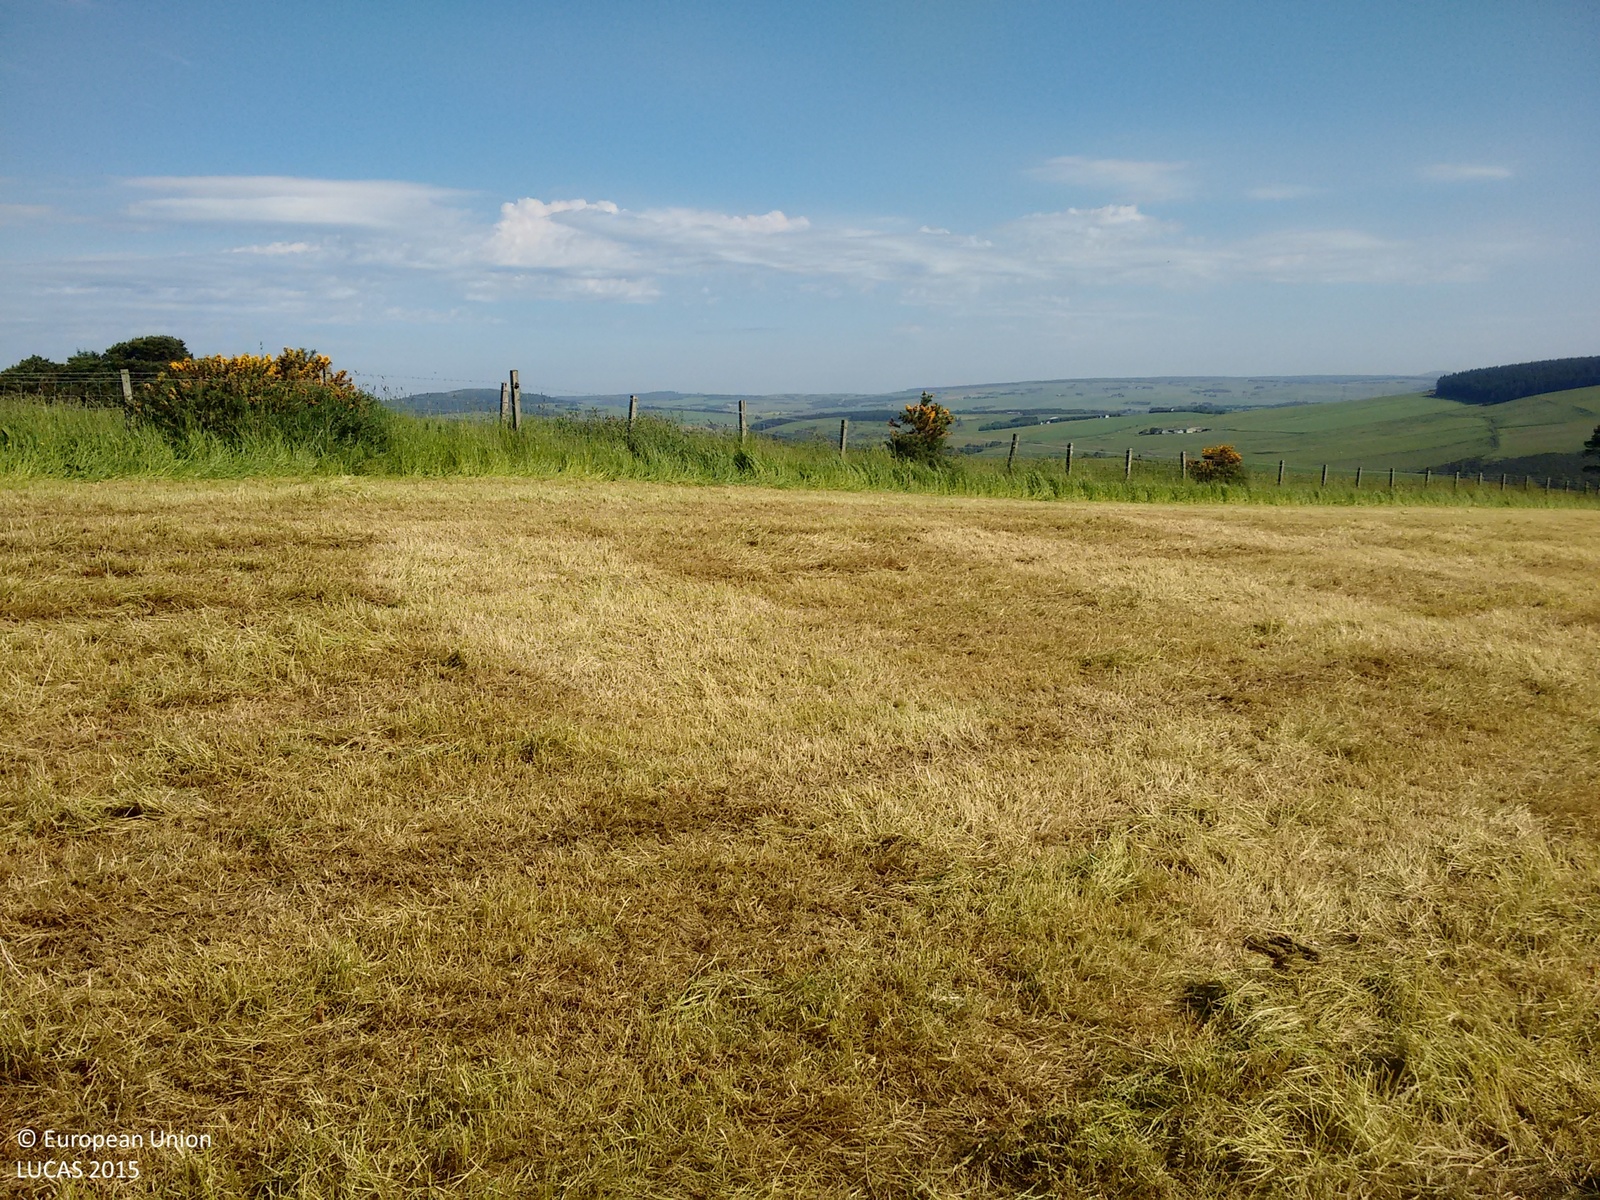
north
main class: Cropland
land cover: Temporary grasslands
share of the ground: > 75 %
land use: Agriculture (excluding fallow land and kitchen gardens)
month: July
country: GB
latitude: 57.4941
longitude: -2.9916
